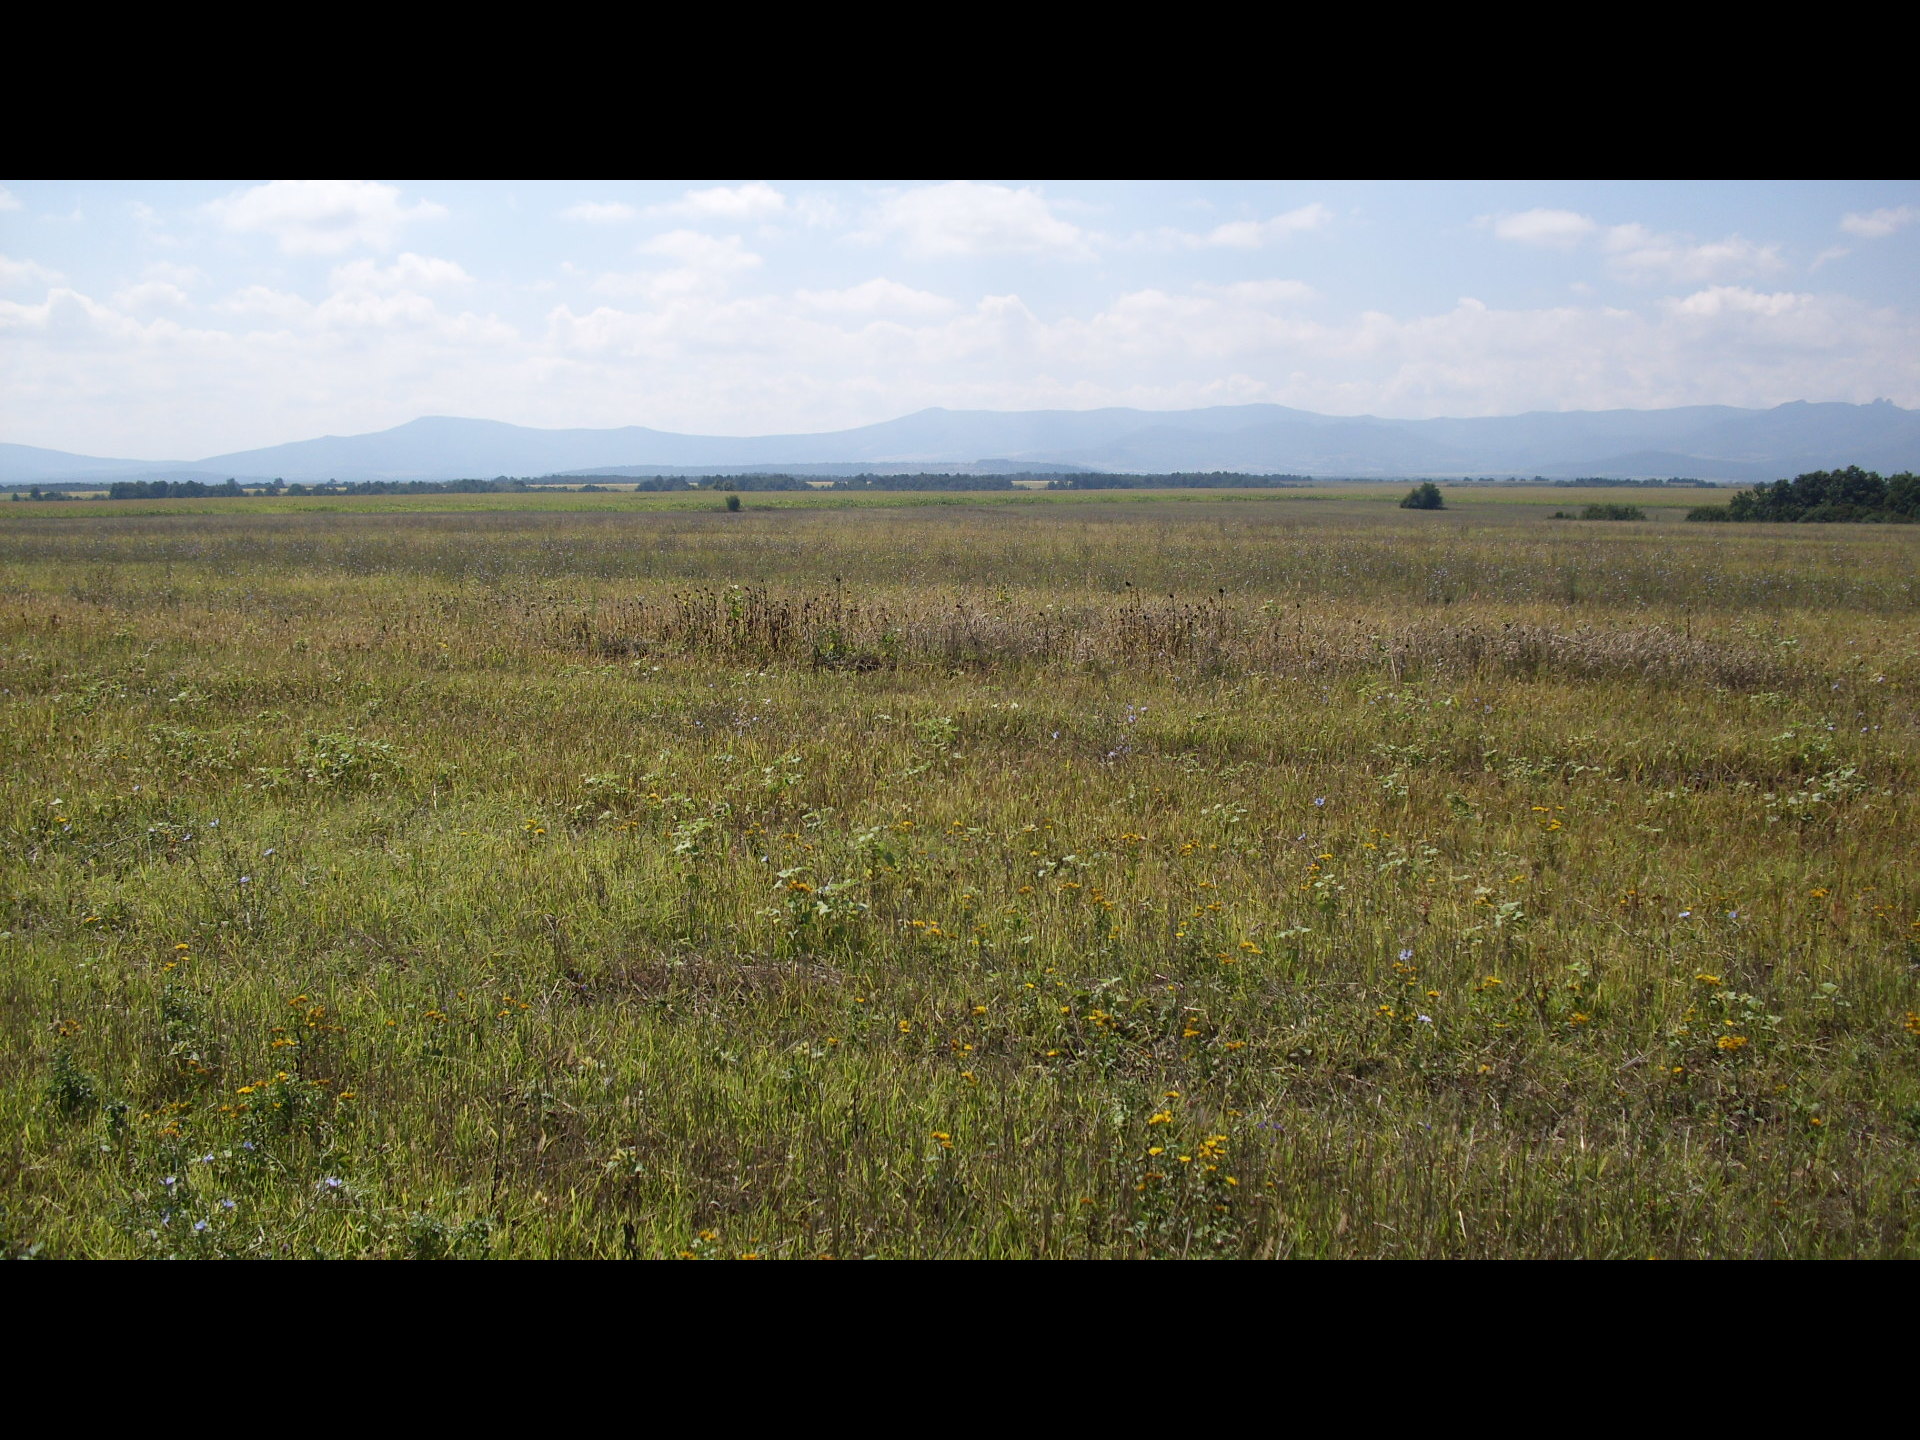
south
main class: Cropland
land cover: Common wheat
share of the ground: 10 - 25 %
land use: Agriculture (excluding fallow land and kitchen gardens)
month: August
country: BG
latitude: 43.6008
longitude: 23.0085
